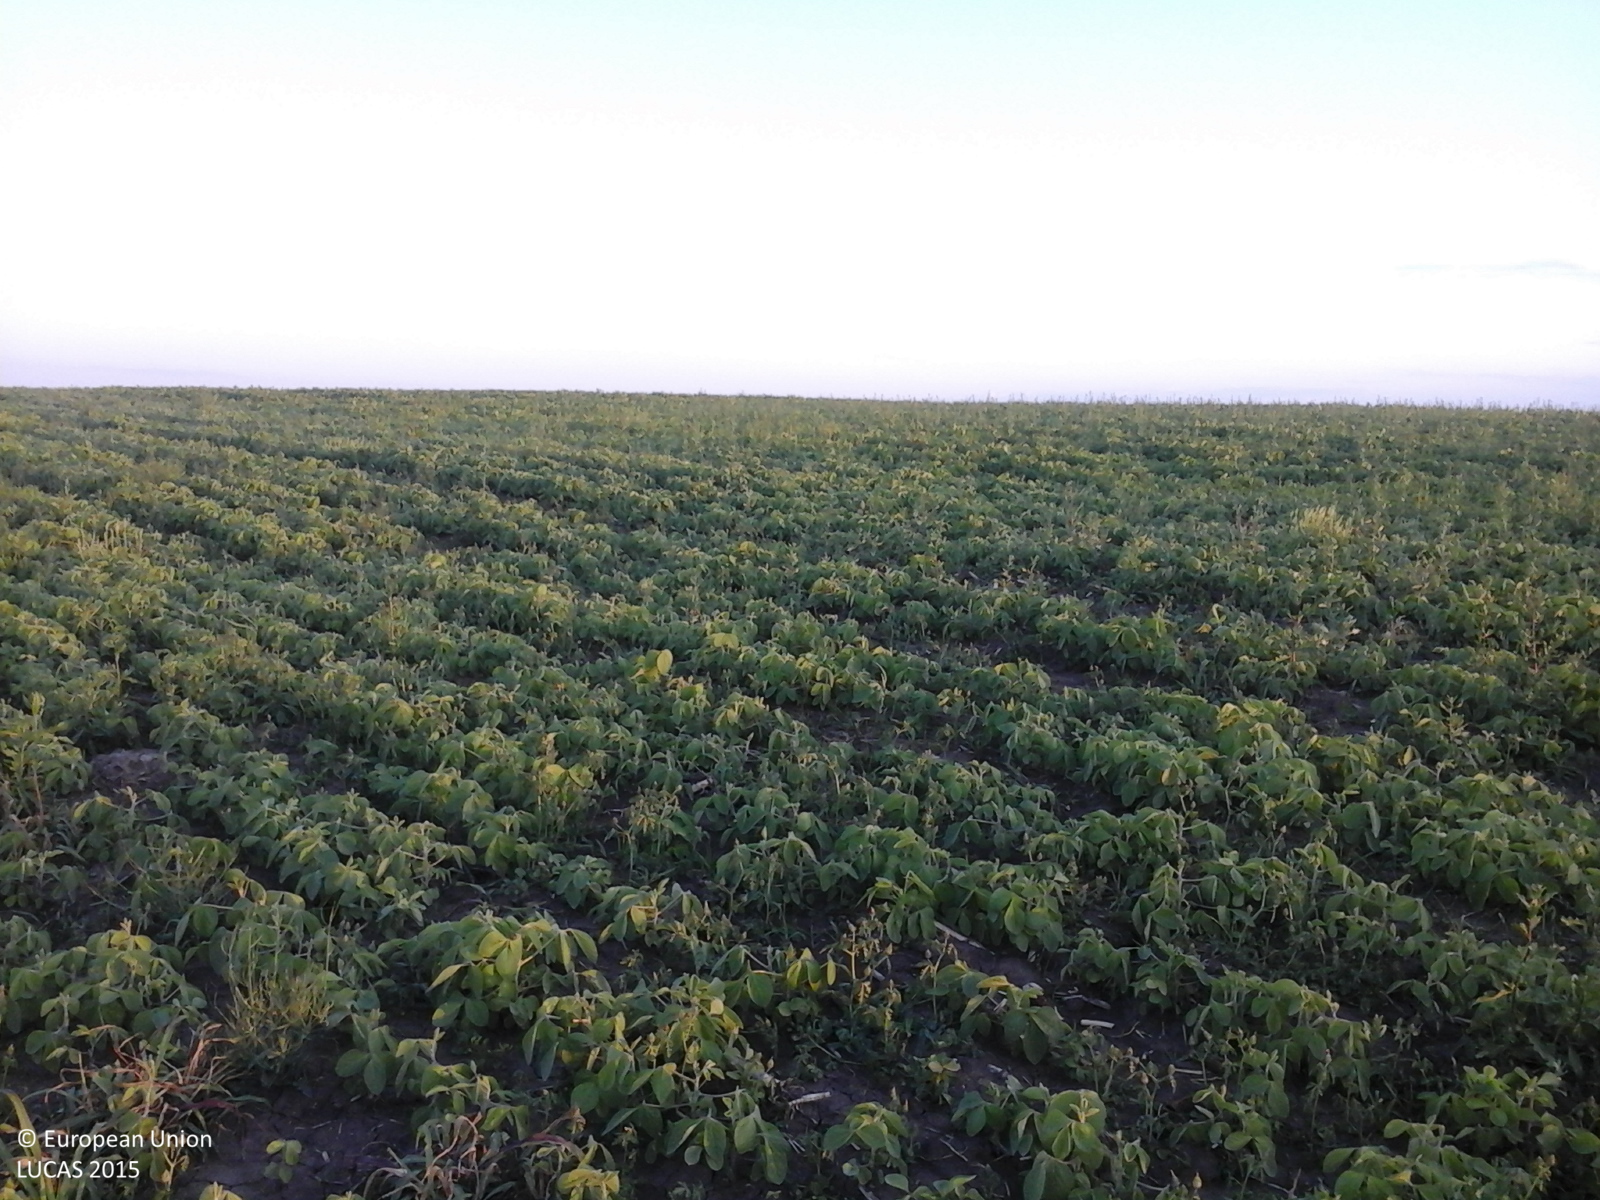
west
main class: Cropland
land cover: Soya
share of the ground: > 75 %
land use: Agriculture (excluding fallow land and kitchen gardens)
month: June
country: RO
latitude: 47.2912
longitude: 27.4779
